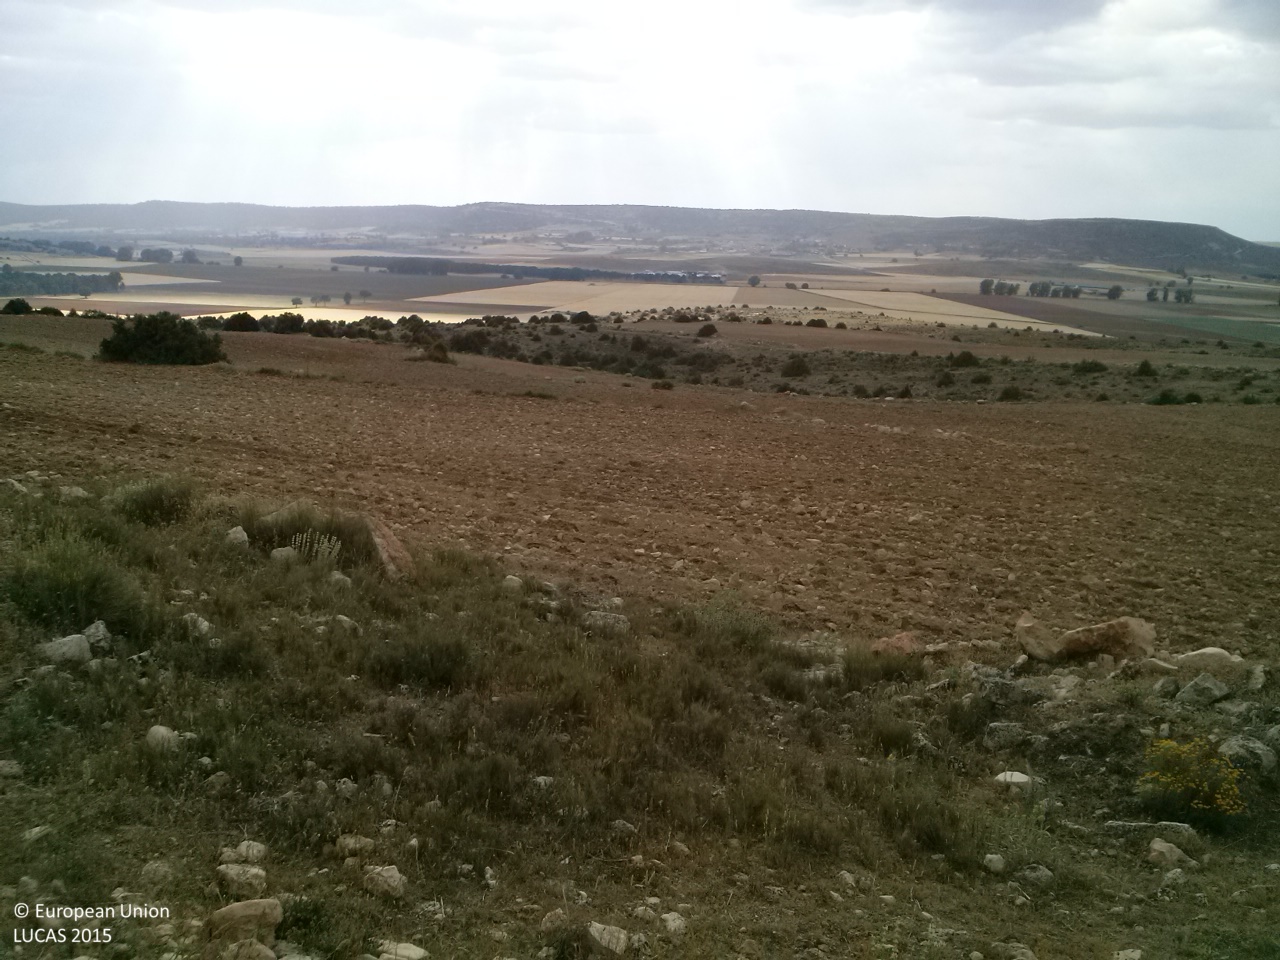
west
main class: Grassland
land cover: Grassland without tree/shrub cover
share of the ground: > 75 %
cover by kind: herbaceous plants 80 %, consolidated bare surface 20 %
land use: Agriculture (excluding fallow land and kitchen gardens)
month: June
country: ES
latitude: 39.8954
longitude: -1.8352
